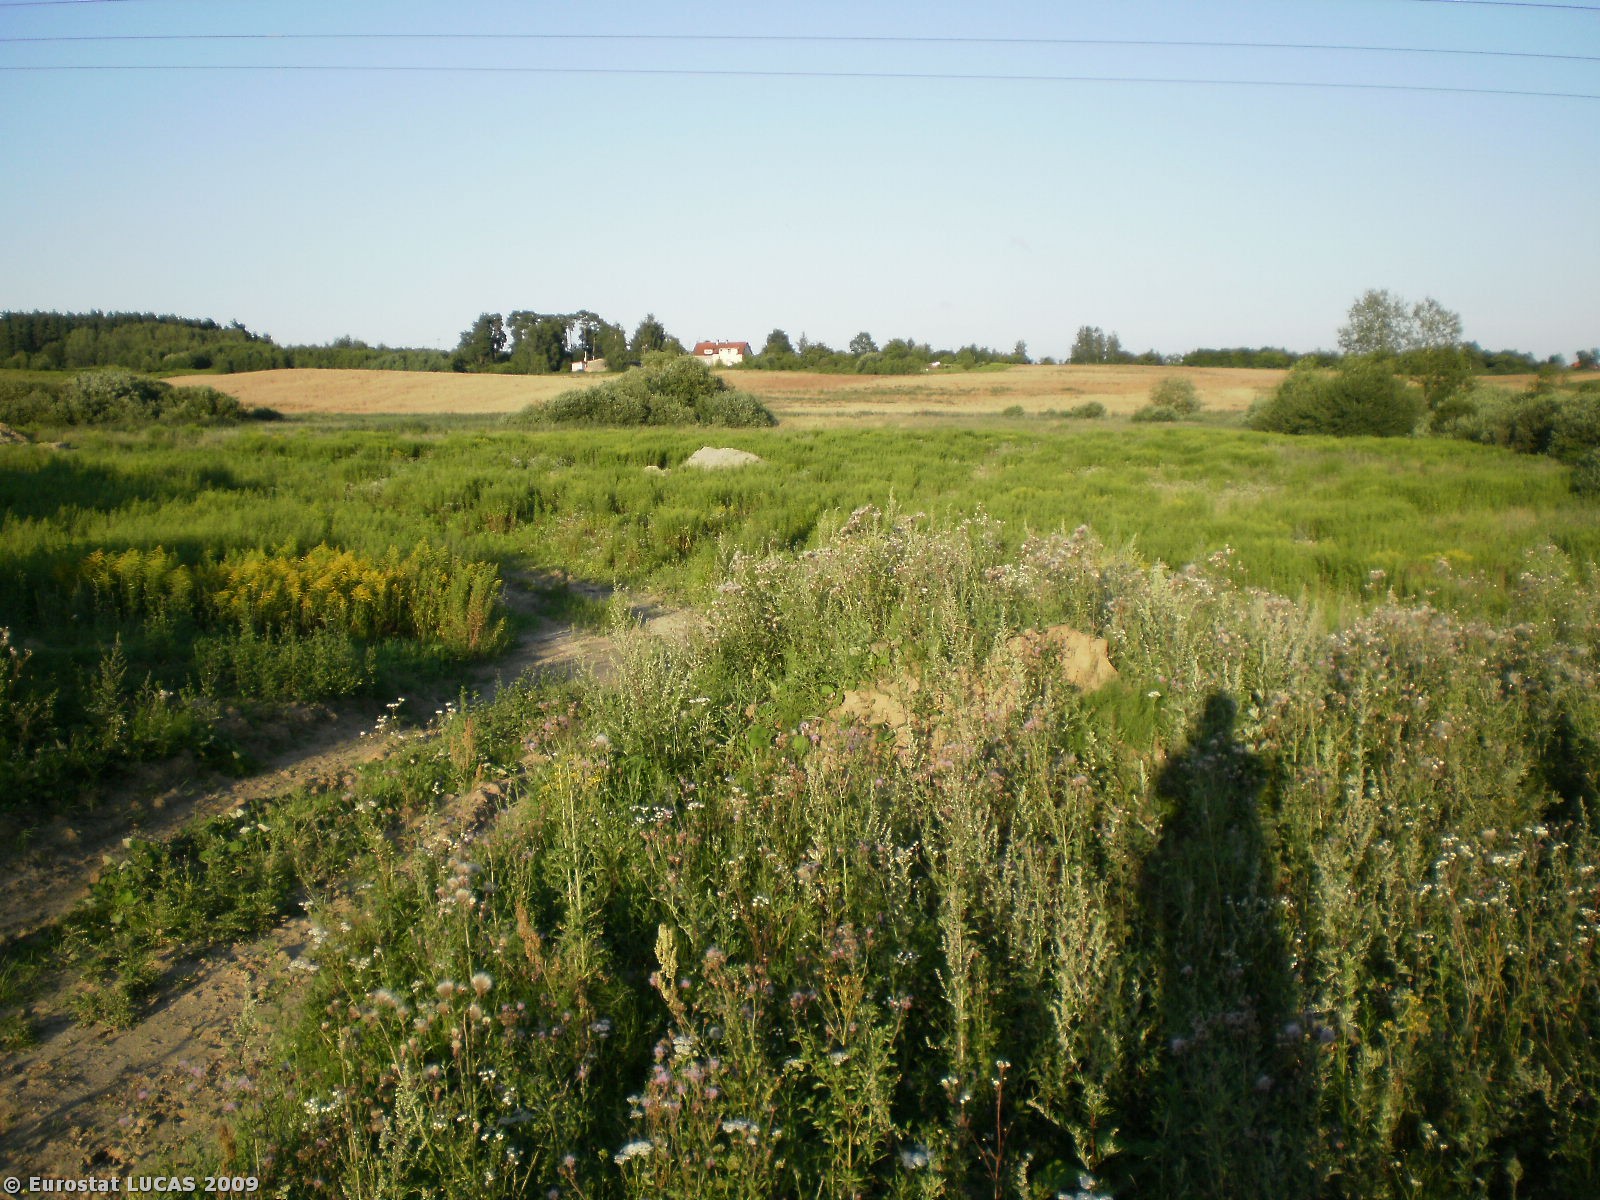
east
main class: Grassland
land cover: Spontaneously vegetated surfaces
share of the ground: > 75 %
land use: Unused
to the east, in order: Spontaneously vegetated surfaces; Electric lines; Spontaneously vegetated surfaces; Inland marshes
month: July
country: PL
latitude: 53.7739
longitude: 20.5527
